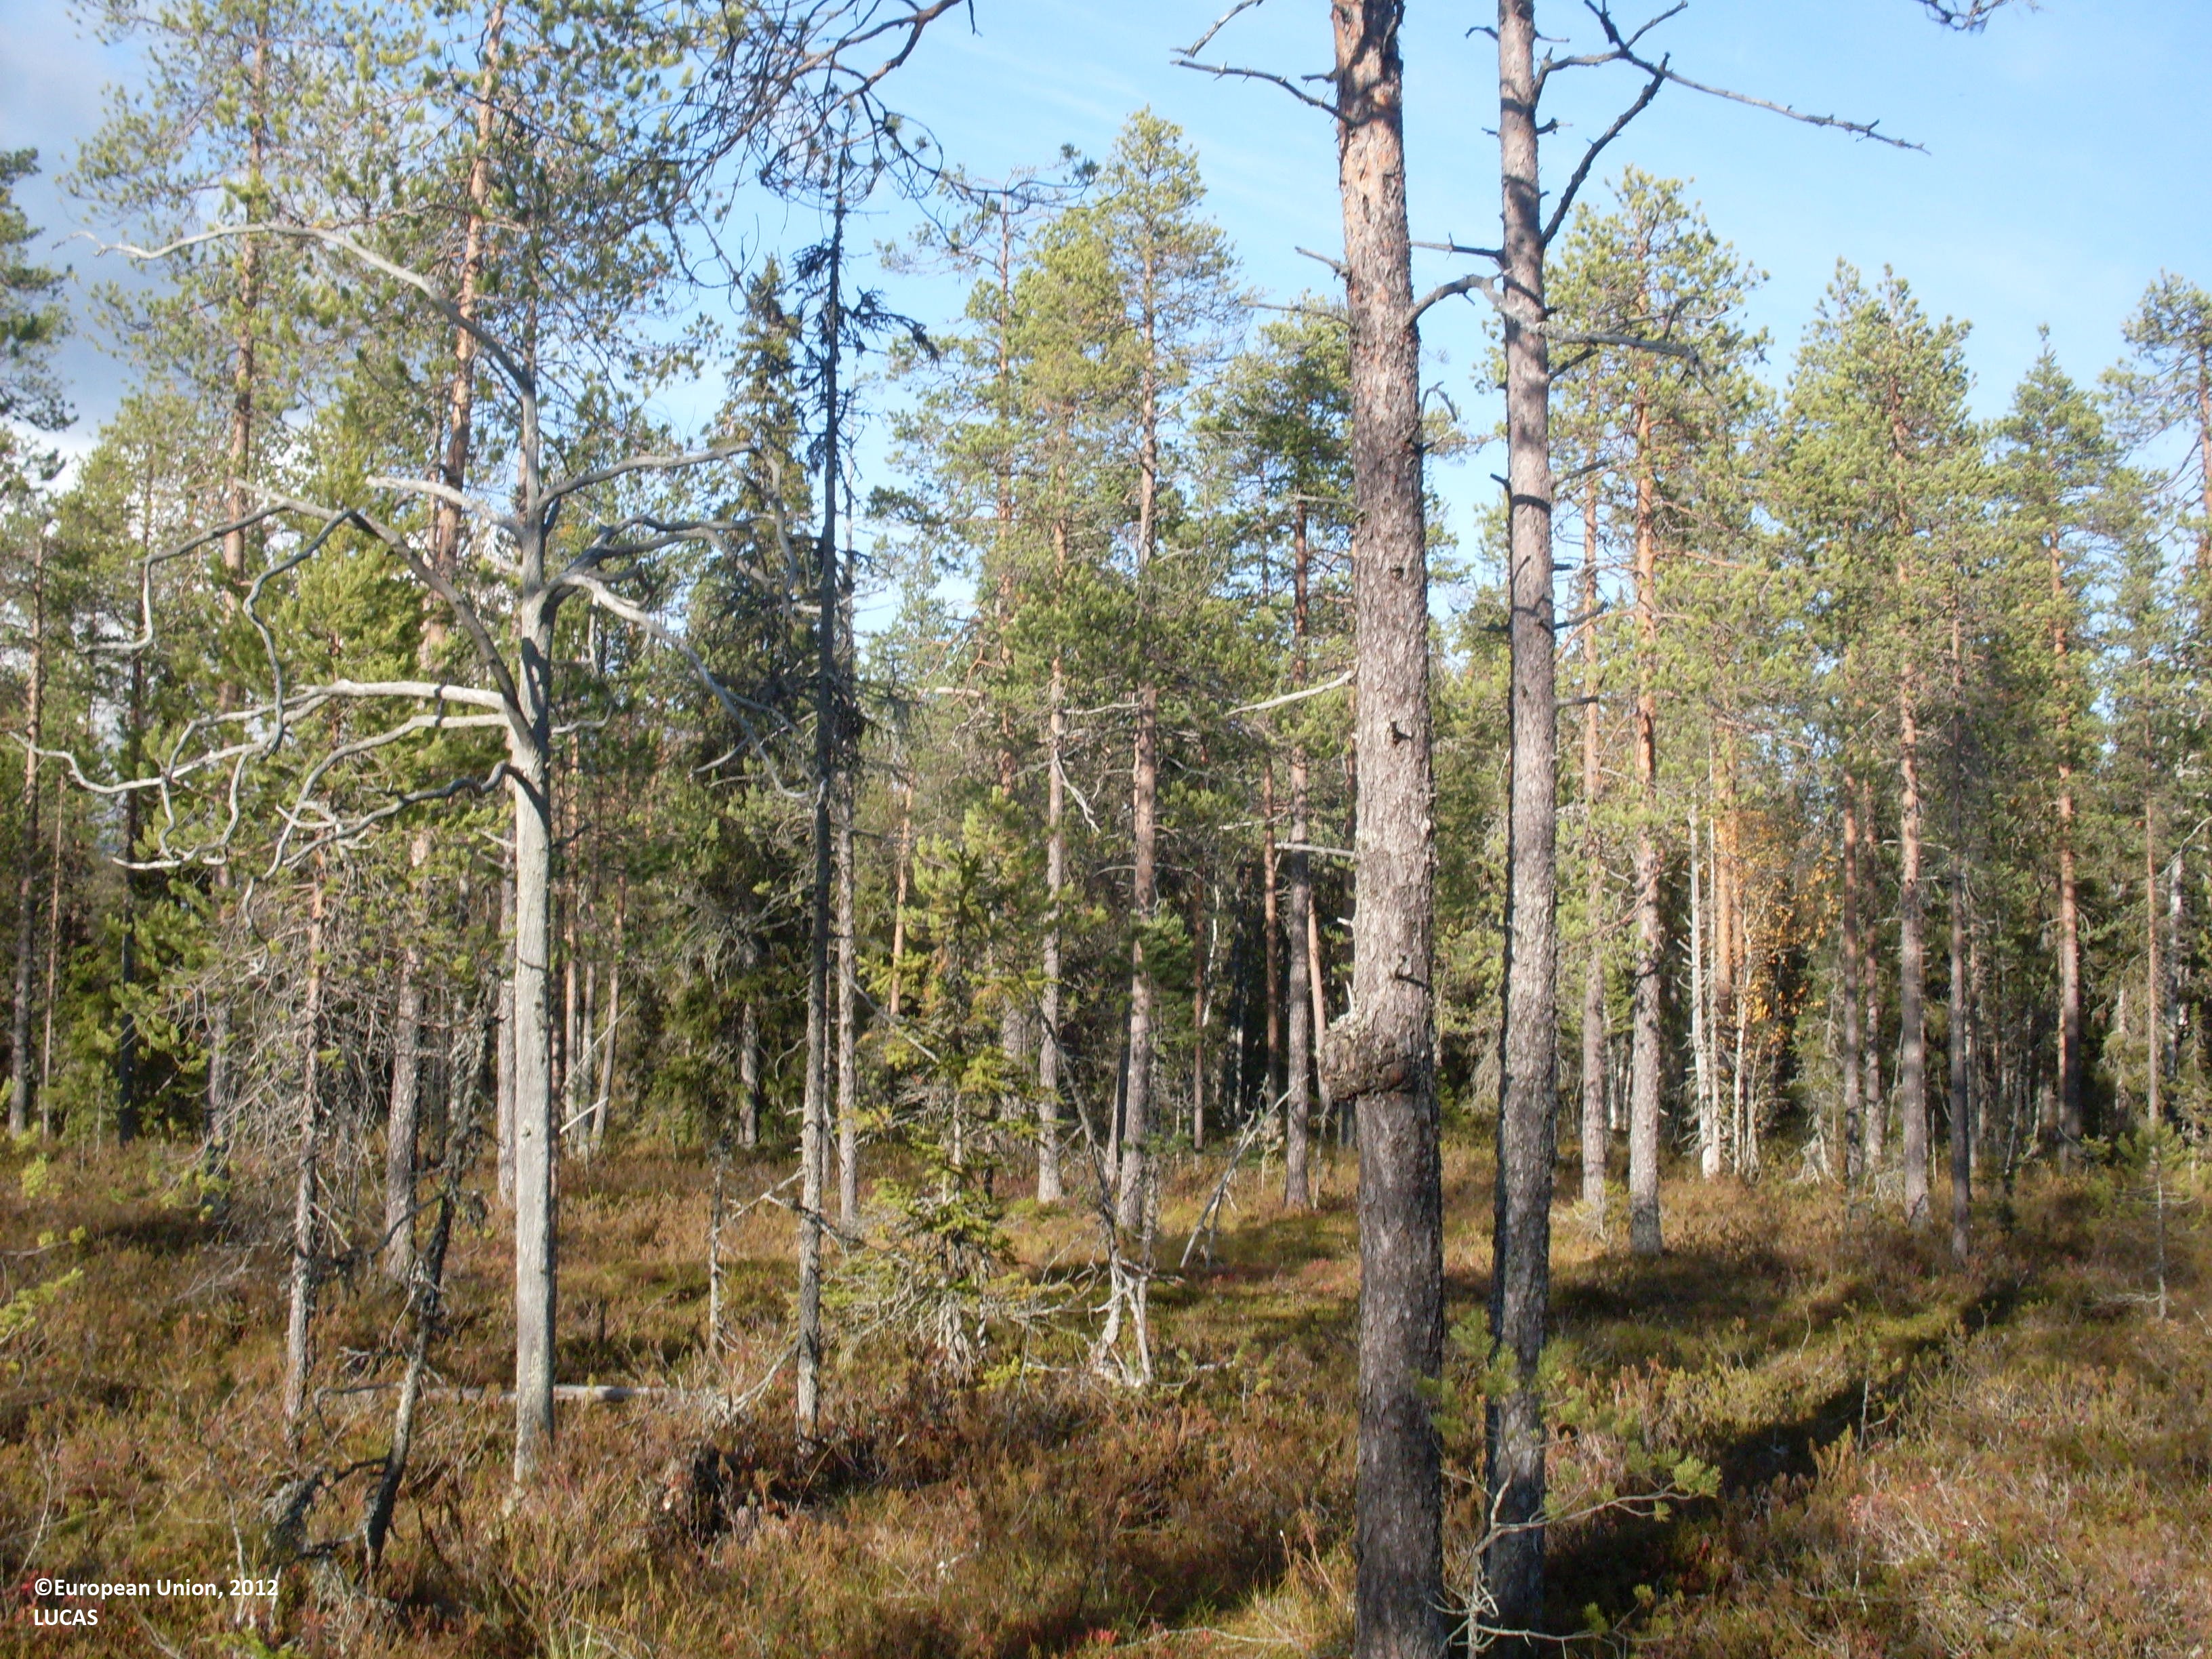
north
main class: Woodland
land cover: Pine dominated coniferous woodland
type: boreal forest
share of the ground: 25 - 50 %
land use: Forestry
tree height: > 5 m
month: September
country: FI
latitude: 64.7728
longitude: 29.7112
